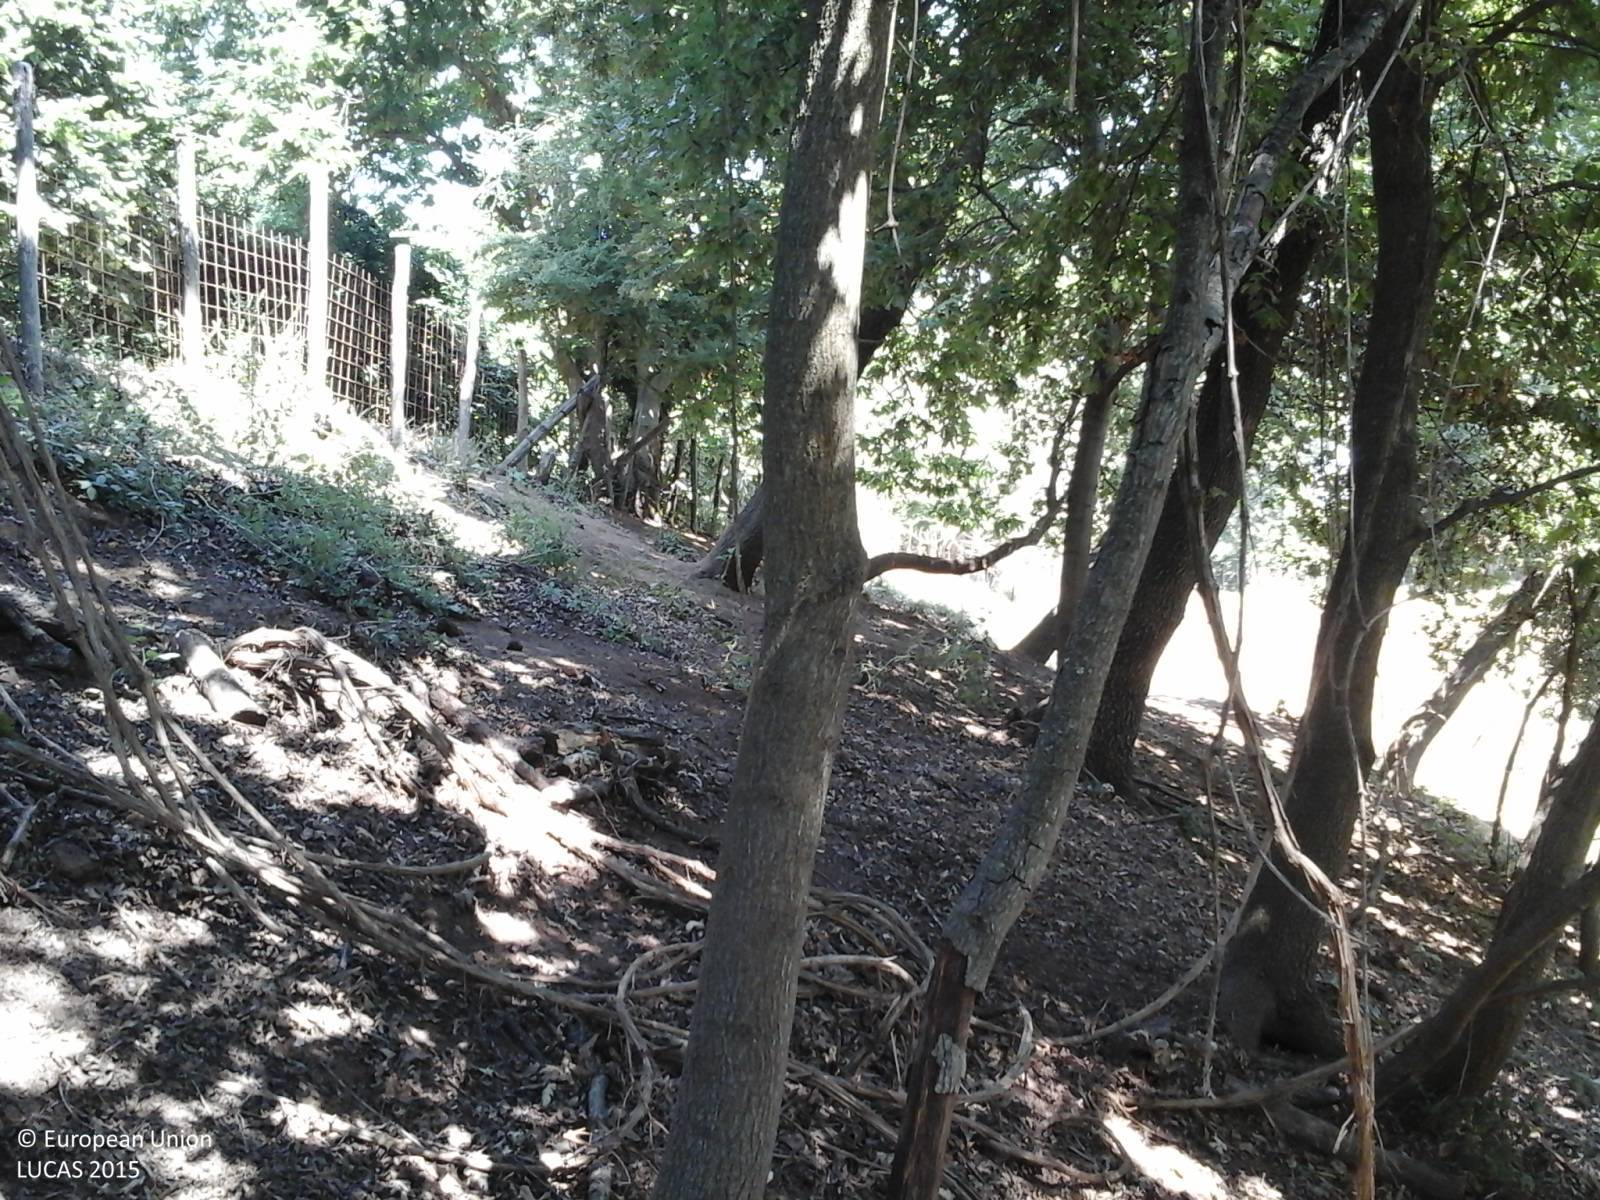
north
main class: Woodland
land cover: Broadleaved woodland
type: thermophilous deciduous forest
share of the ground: > 75 %
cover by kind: broadleaved forest trees 100 %
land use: Agriculture (excluding fallow land and kitchen gardens)
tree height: > 5 m
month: August
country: IT
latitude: 42.2138
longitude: 12.2331
